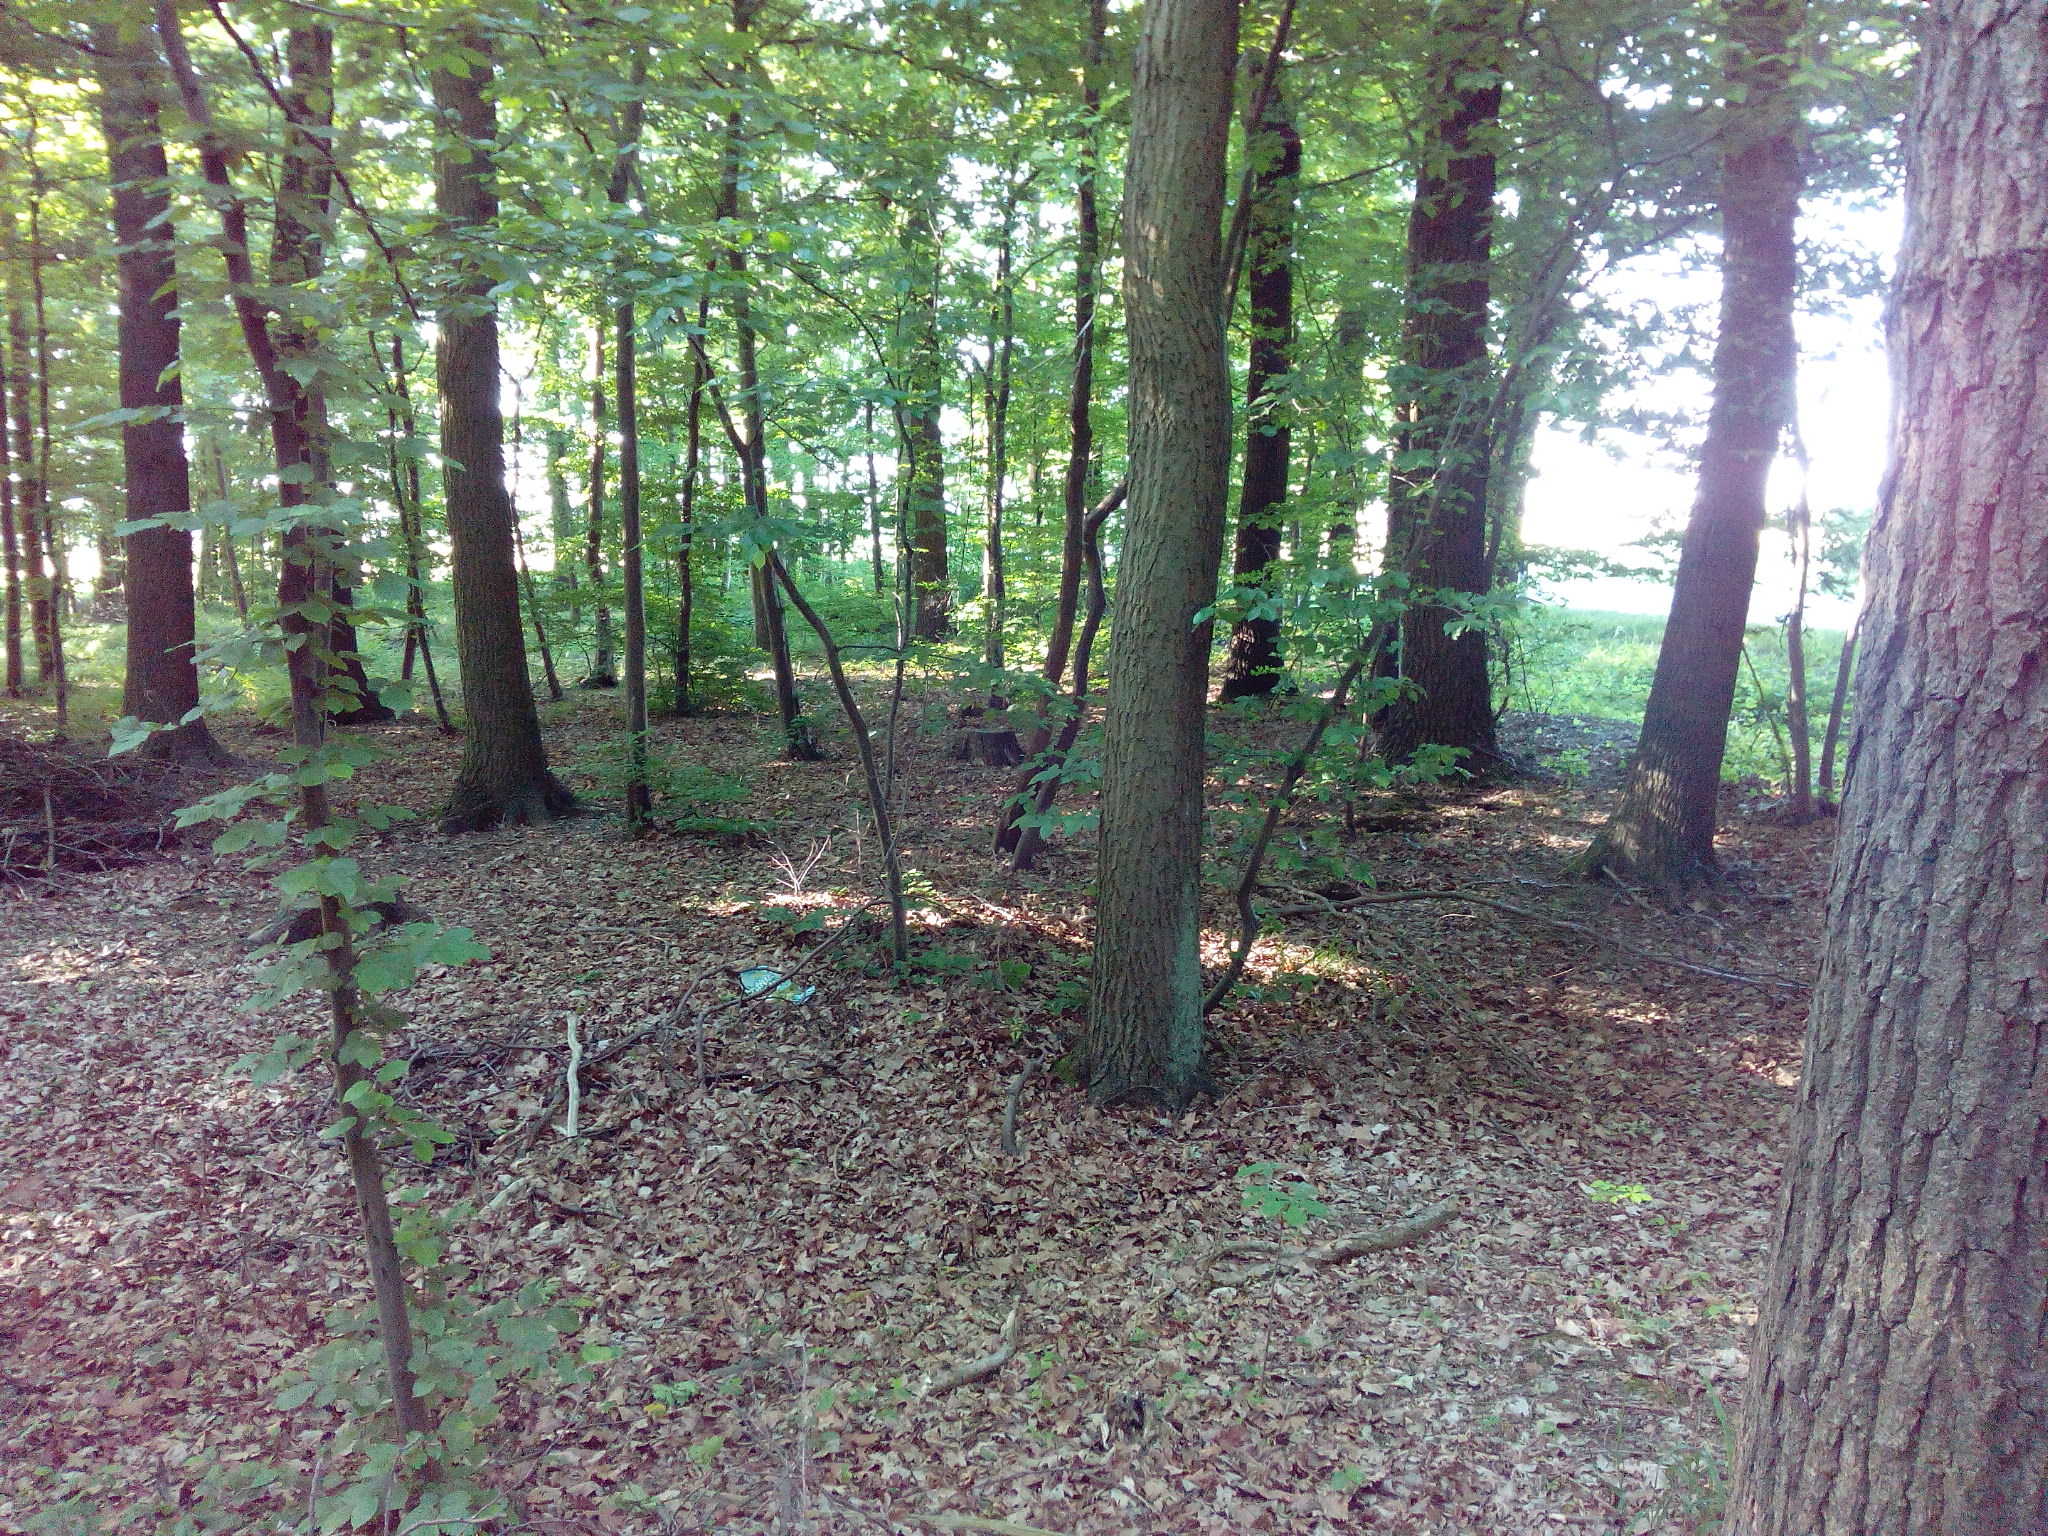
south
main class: Woodland
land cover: Broadleaved woodland
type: hemiboreal forest and nemoral coniferous forest and mixed broadleaved-coniferous forest
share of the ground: > 75 %
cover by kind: broadleaved forest trees 90 %, shrubs 5 %, herbaceous plants 5 %
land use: Forestry
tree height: > 5 m
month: June
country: DE
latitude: 52.3055
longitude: 9.8974
